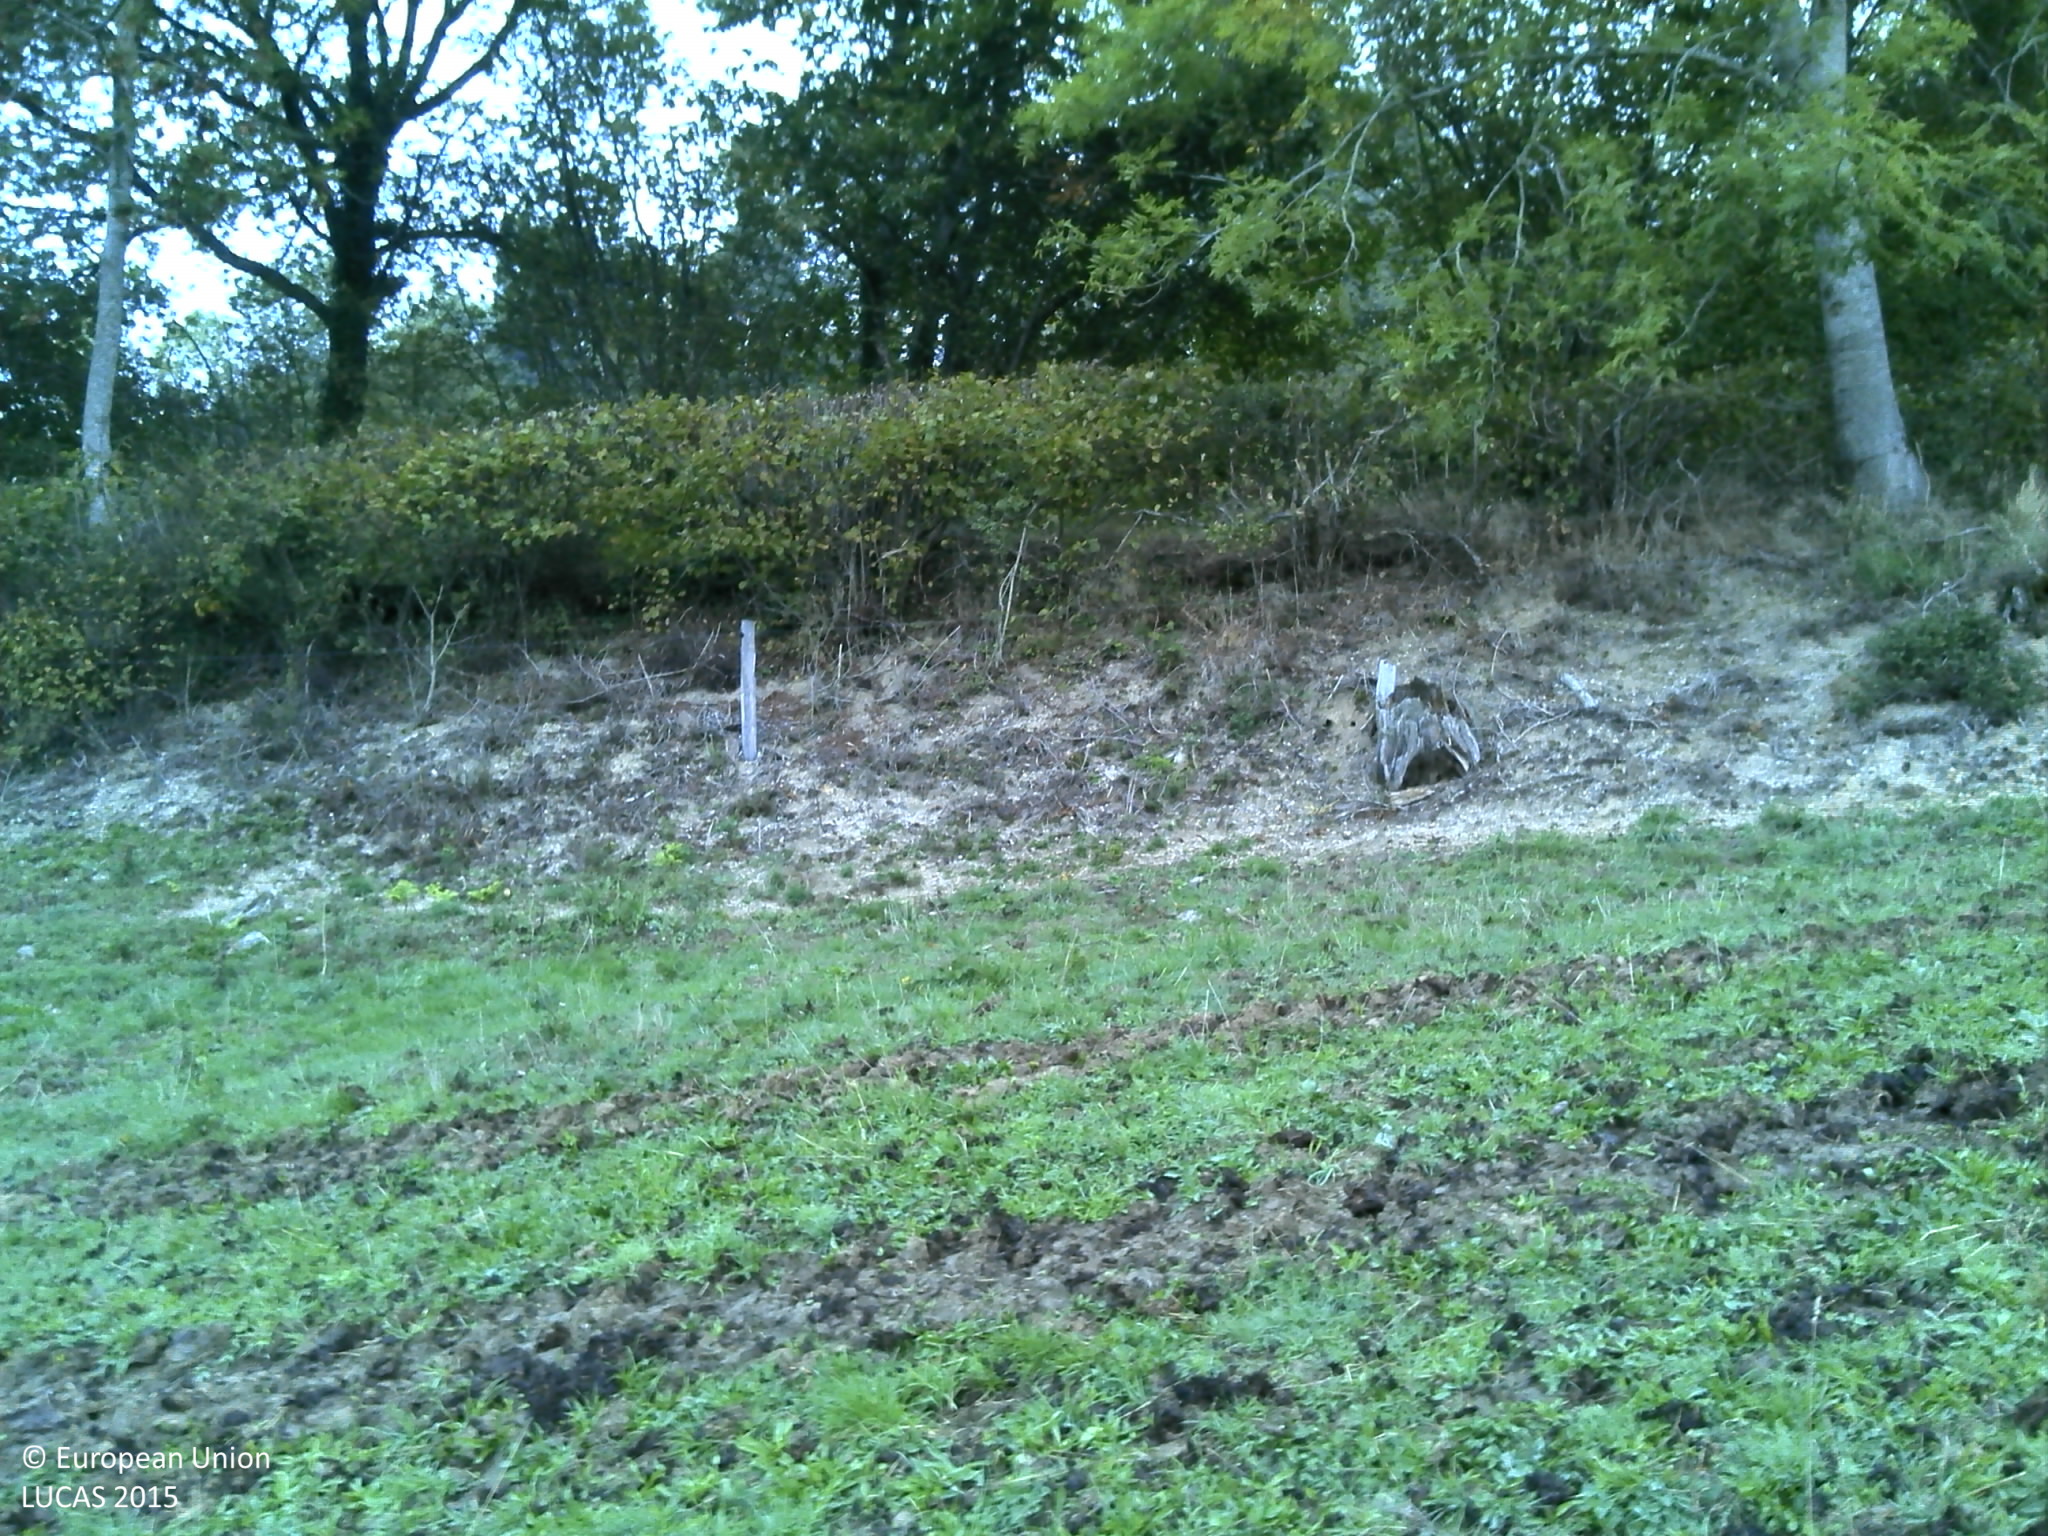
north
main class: Grassland
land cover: Grassland without tree/shrub cover
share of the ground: > 75 %
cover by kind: herbaceous plants 100 %
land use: Agriculture (excluding fallow land and kitchen gardens)
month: October
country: FR
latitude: 46.7809
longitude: 4.0401
